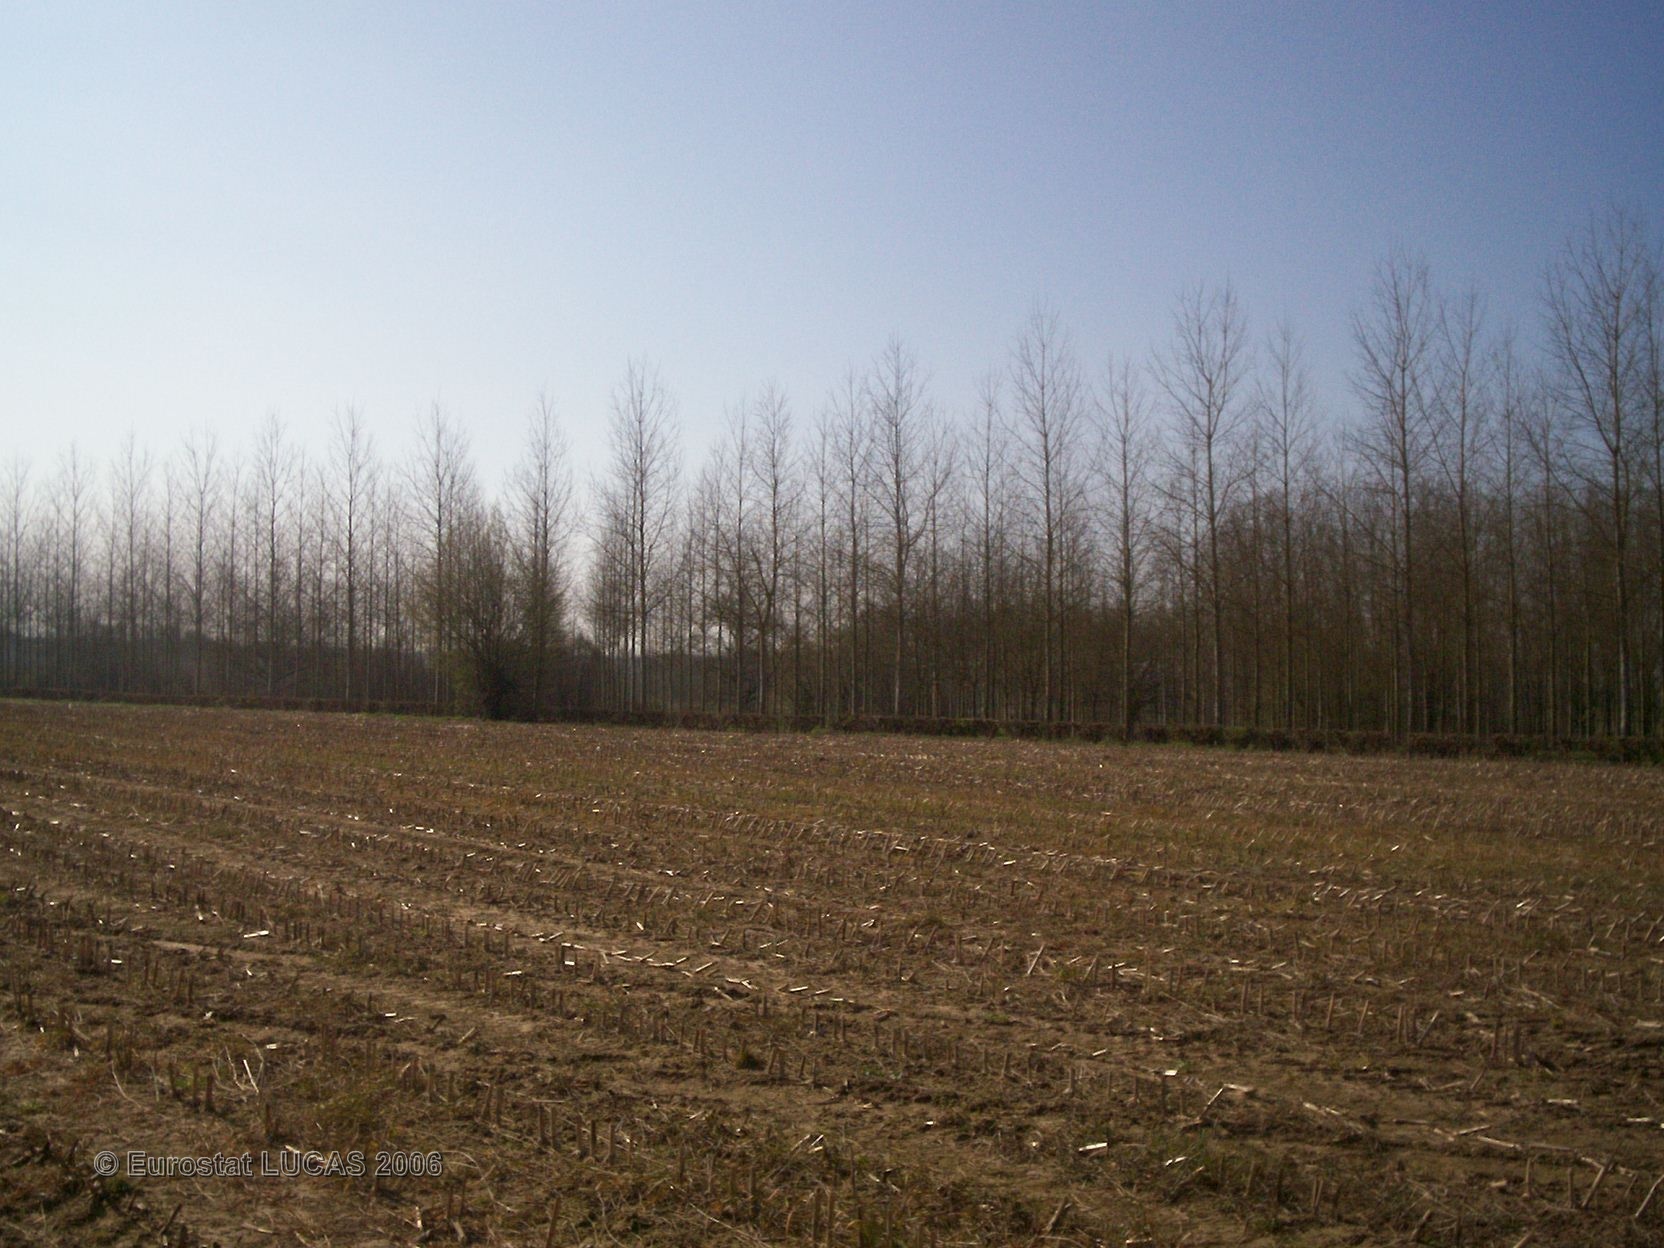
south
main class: Cropland
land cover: Maize
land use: Agriculture (excluding fallow land and kitchen gardens)
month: April
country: FR
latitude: 50.1369
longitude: 3.7113
